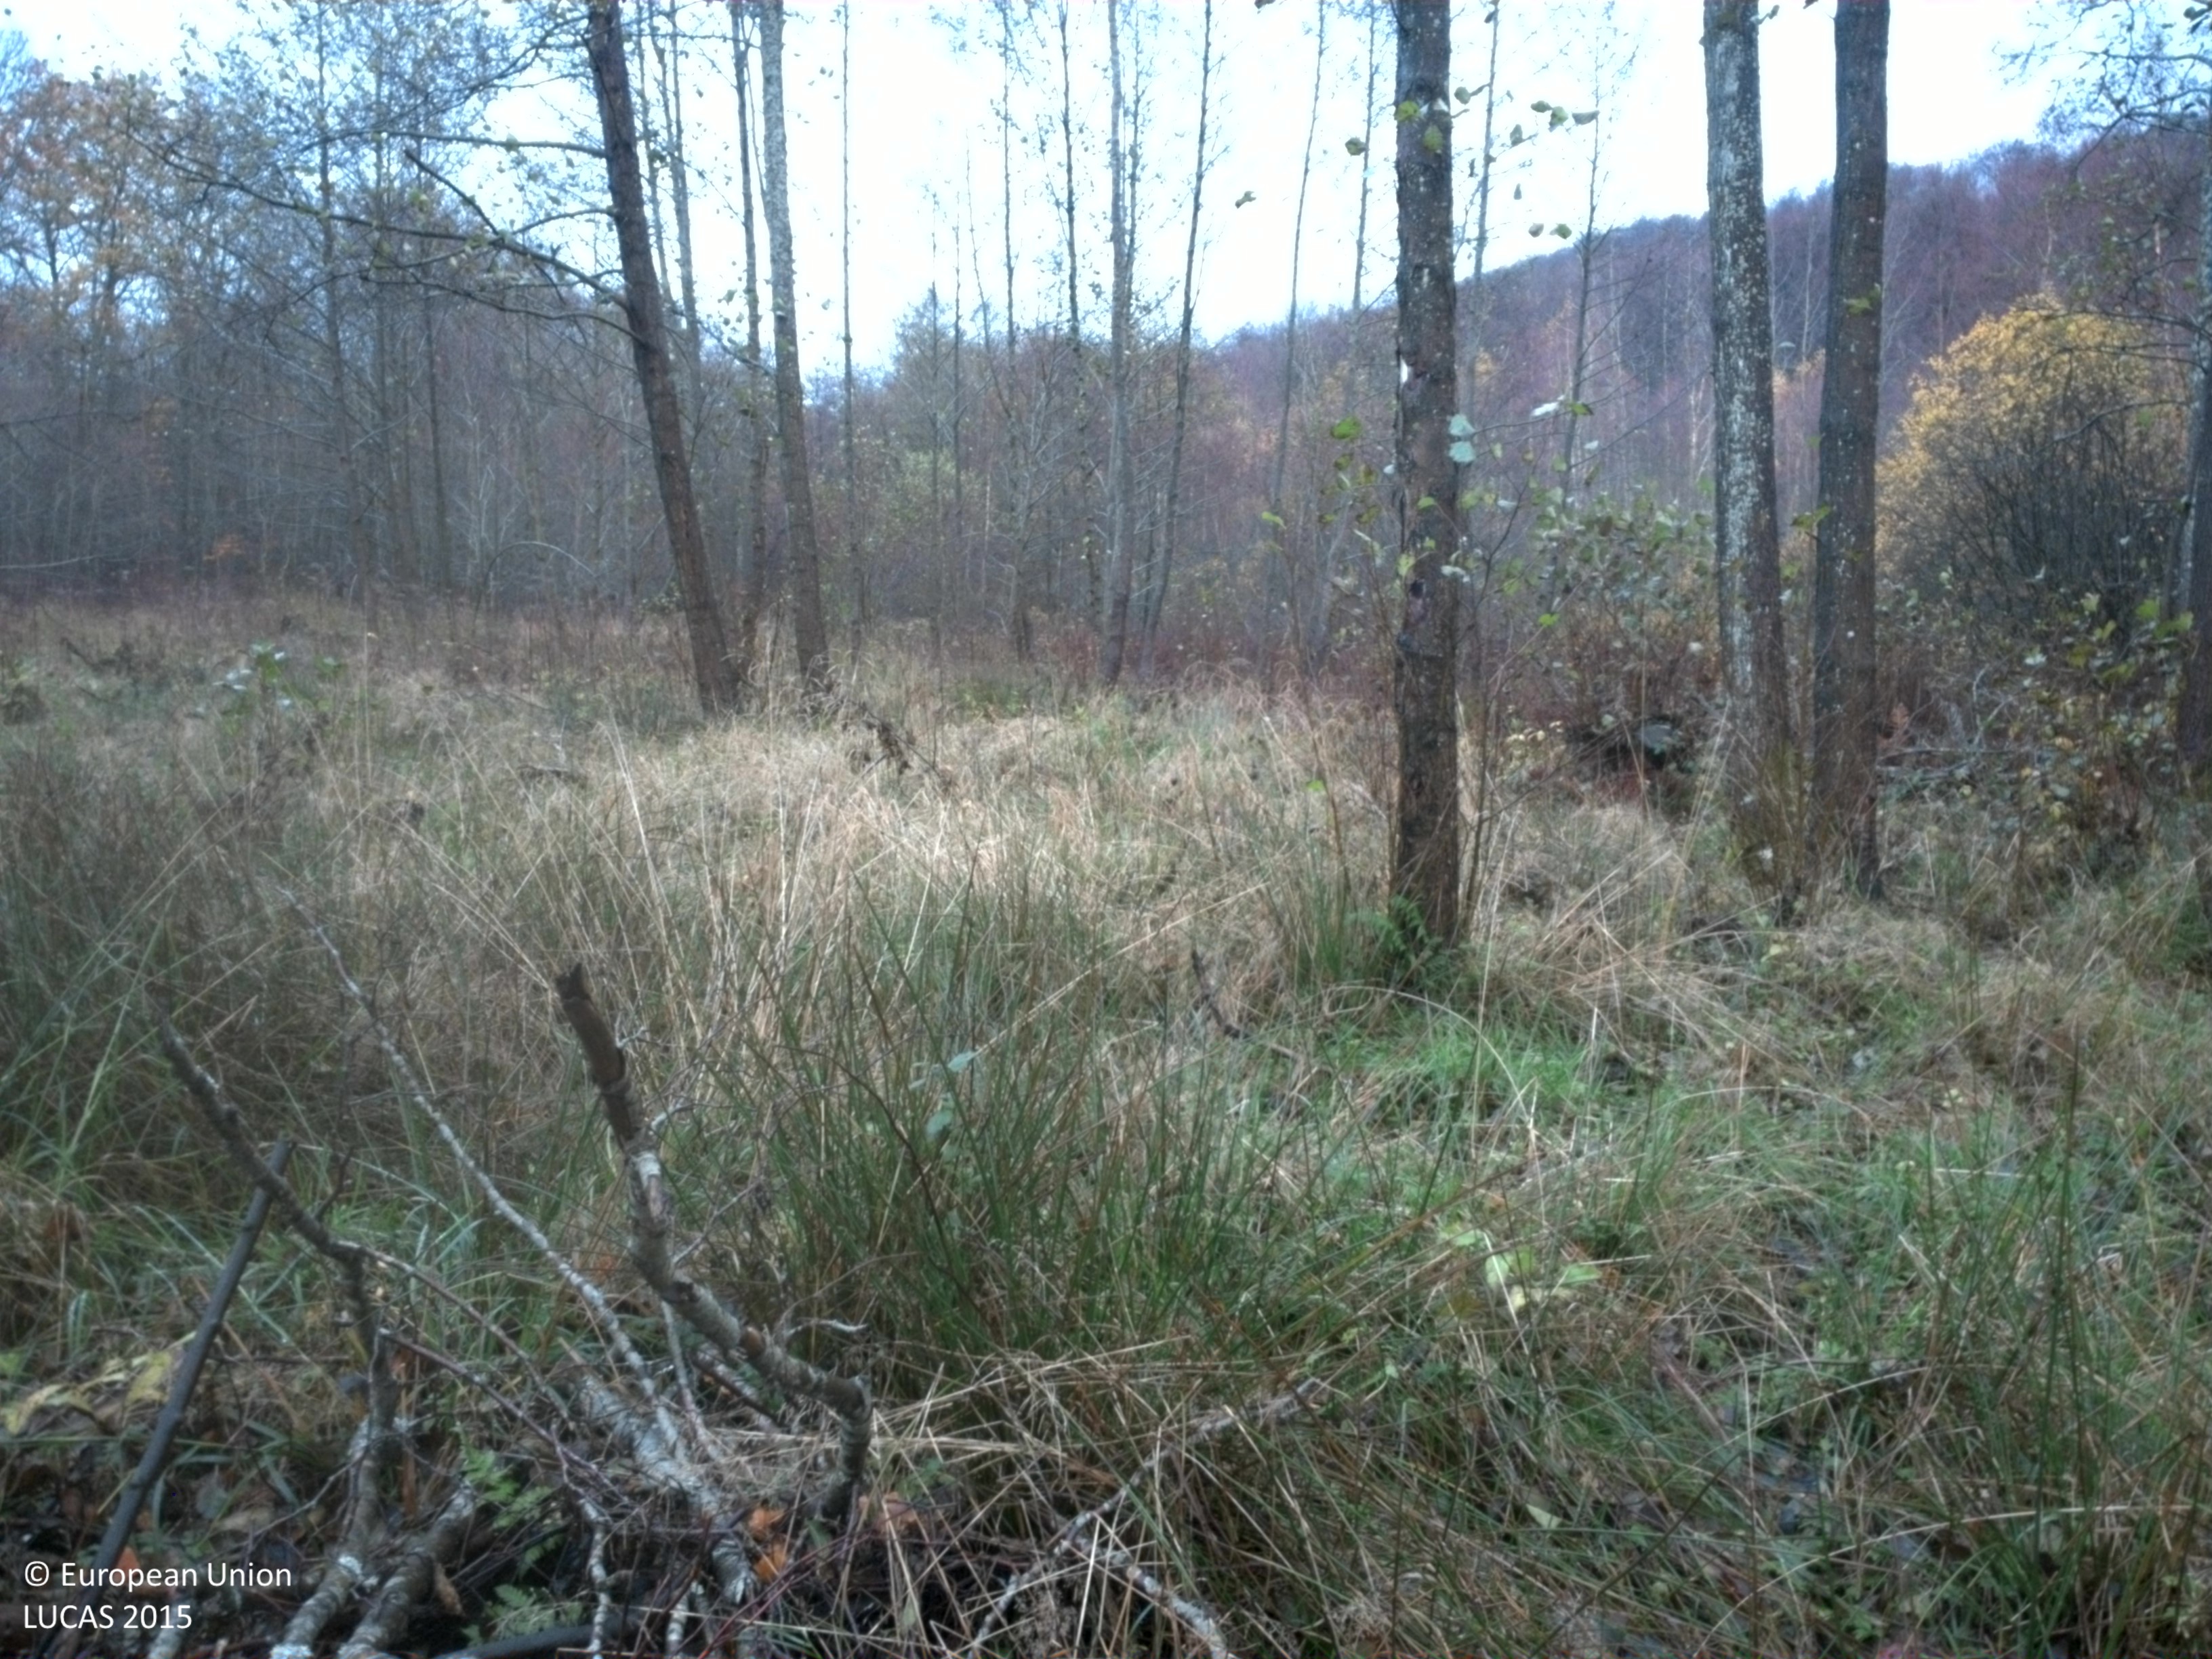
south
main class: Woodland
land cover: Broadleaved woodland
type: hemiboreal forest and nemoral coniferous forest and mixed broadleaved-coniferous forest
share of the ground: 50 - 75 %
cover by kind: broadleaved forest trees 55 %, herbaceous plants 35 %, shrubs 10 %
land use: Forestry
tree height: > 5 m
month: November
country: SE
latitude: 56.0769
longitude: 13.1626
